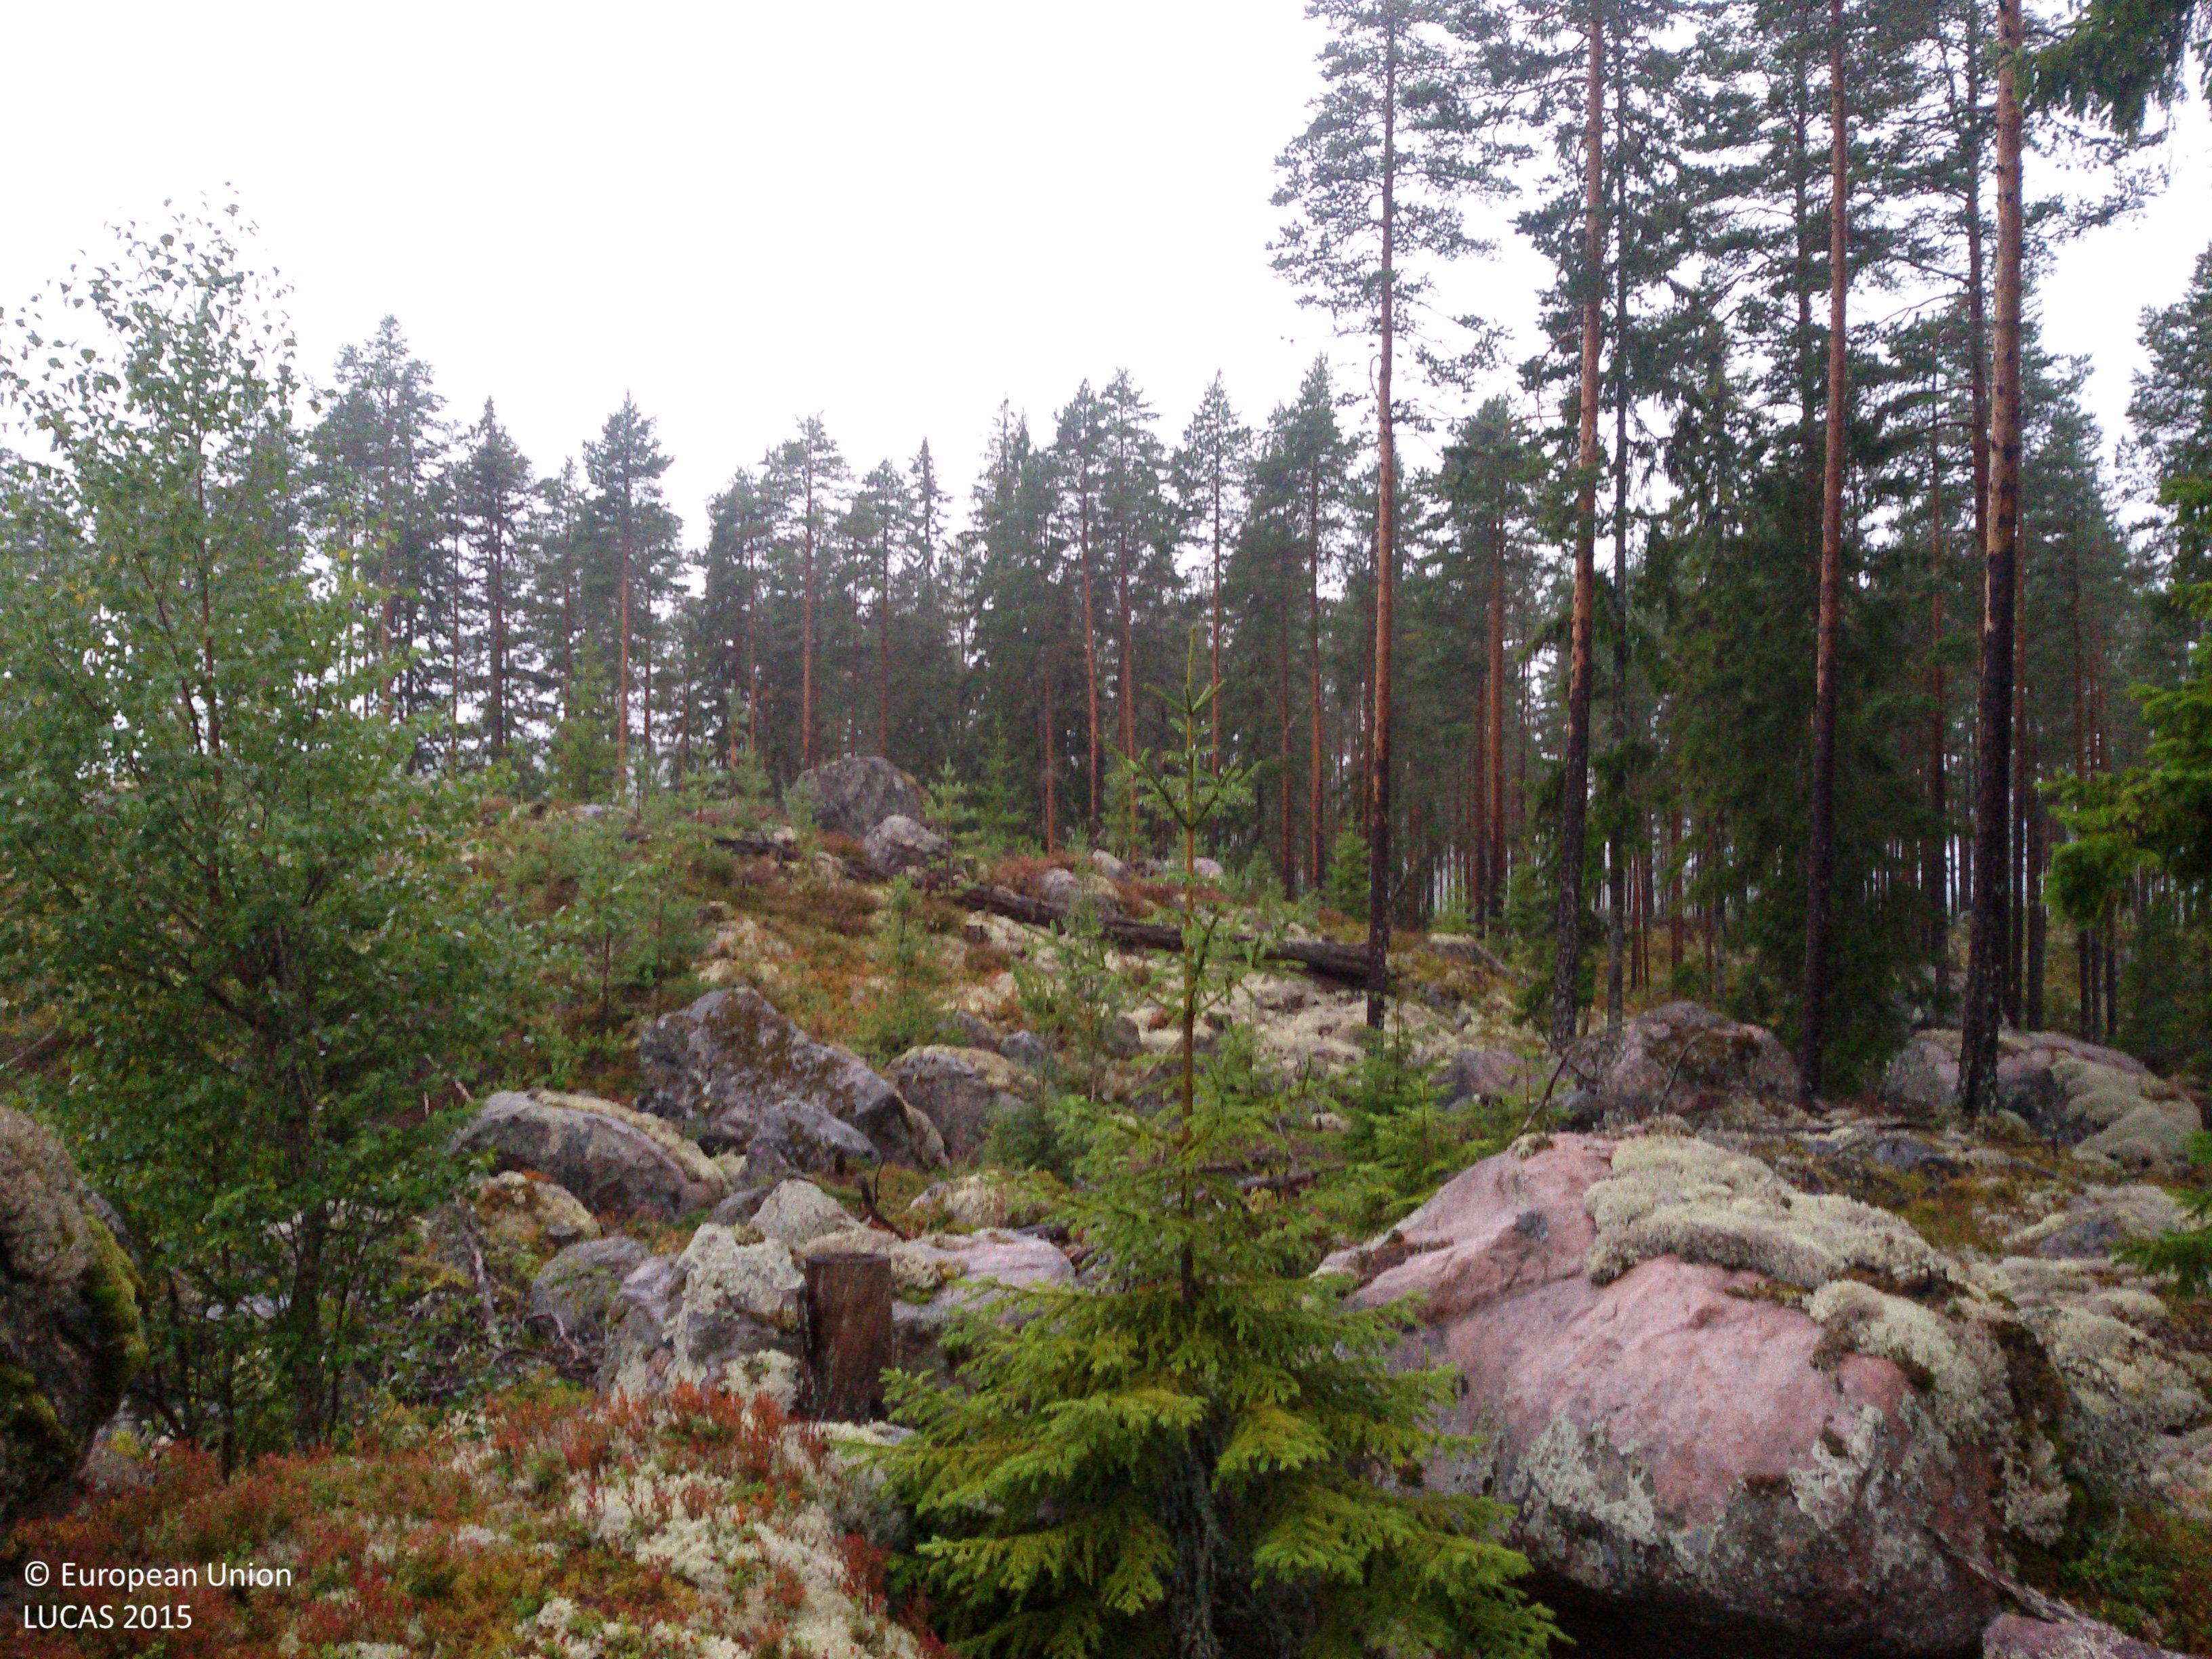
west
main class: Woodland
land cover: Pine dominated coniferous woodland
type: boreal forest
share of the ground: 10 - 25 %
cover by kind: herbaceous plants 40 %, lichens and mosses 40 %, coniferous forest trees 15 %, broadleaved forest trees 5 %
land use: Forestry
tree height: < 5 m
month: September
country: SE
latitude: 60.9836
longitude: 15.7706
